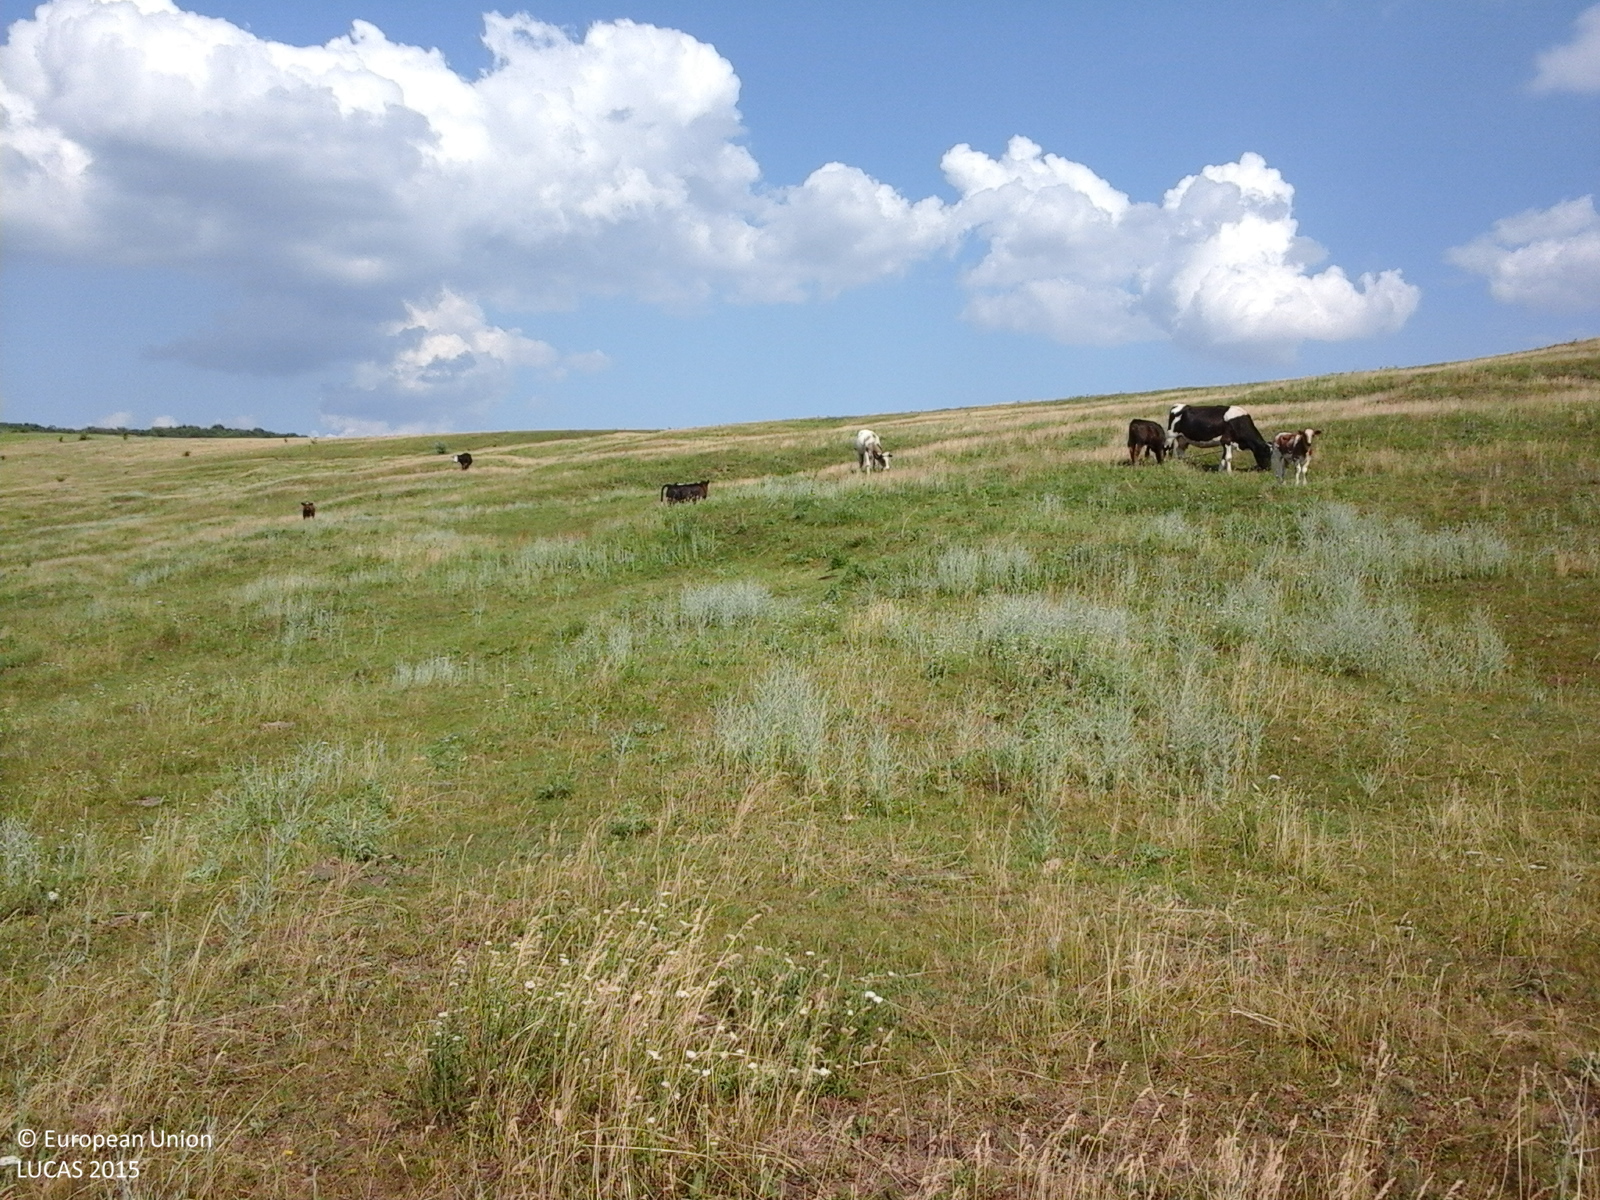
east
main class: Grassland
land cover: Grassland without tree/shrub cover
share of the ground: > 75 %
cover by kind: herbaceous plants 100 %
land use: Agriculture (excluding fallow land and kitchen gardens)
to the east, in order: Grassland without tree/shrub cover
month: June
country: RO
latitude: 47.6044
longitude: 26.9008
